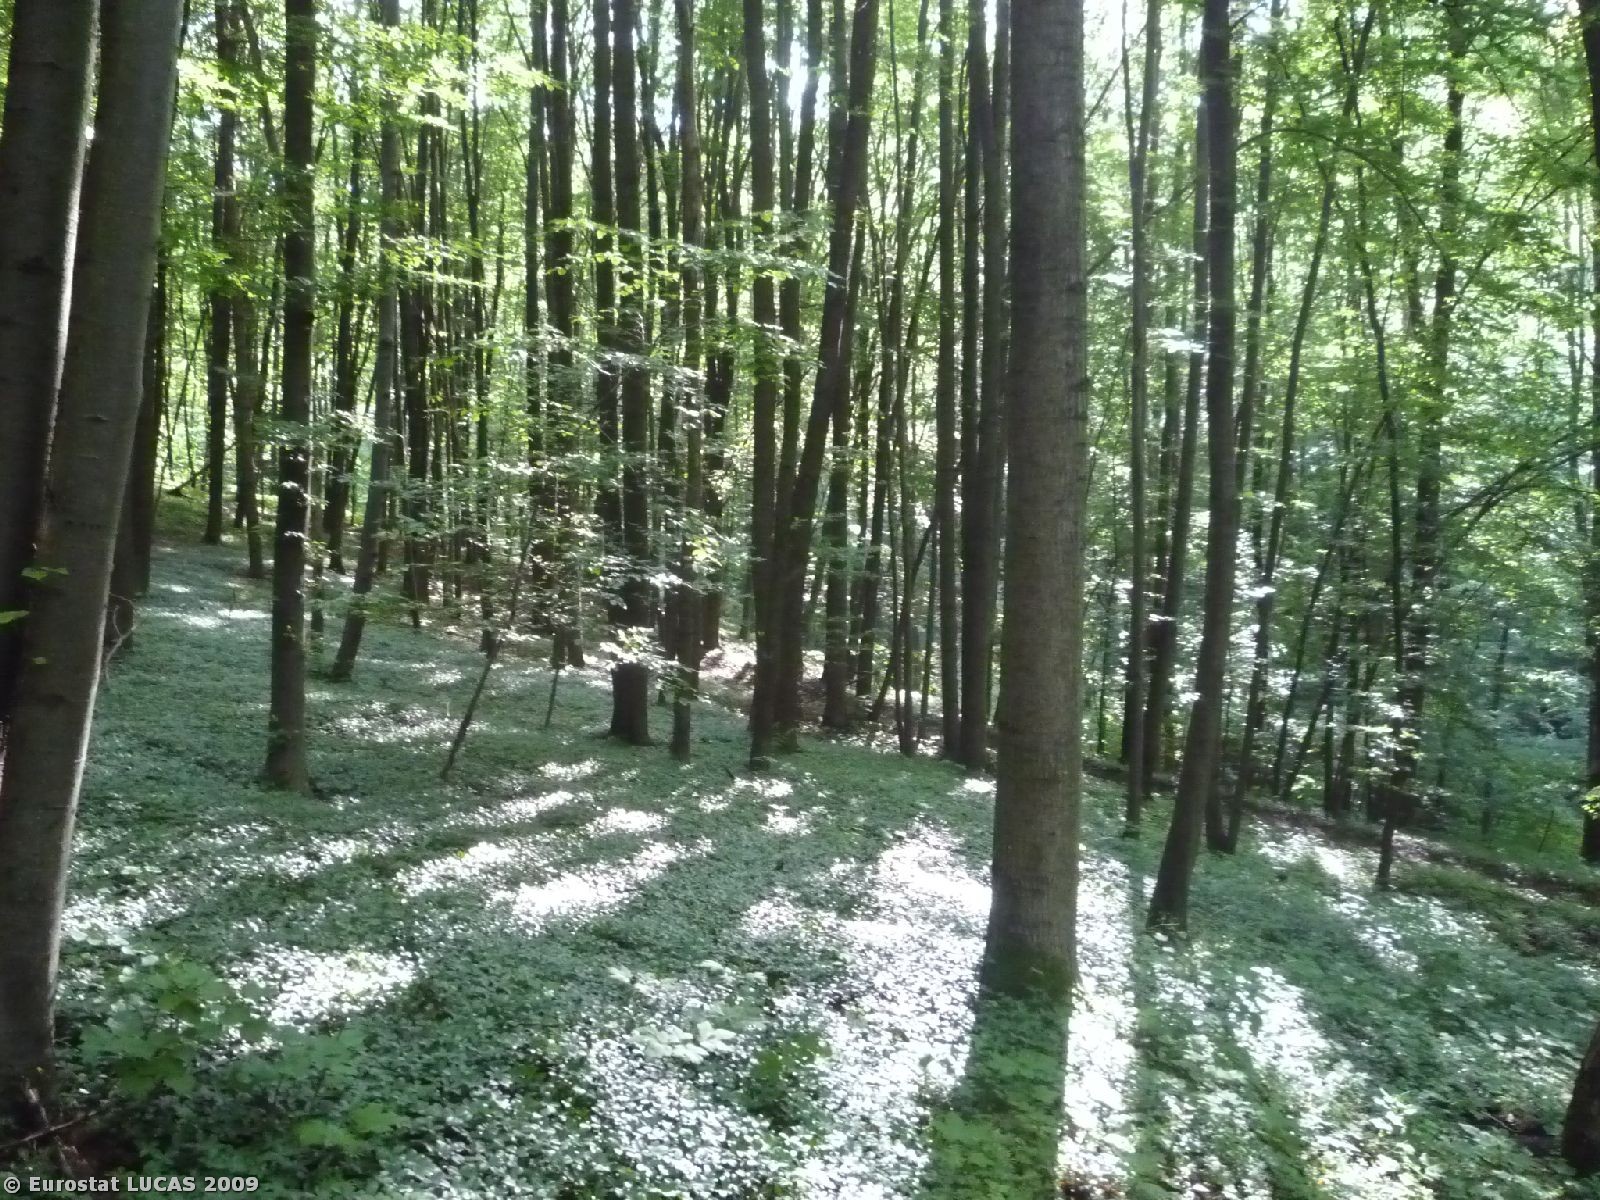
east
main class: Woodland
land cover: Broadleaved woodland
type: beech forest
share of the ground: > 75 %
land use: Forestry
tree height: > 5 m
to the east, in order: Broadleaved woodland; Tracks; Broadleaved woodland; Rivers and streams; Coniferous woodland; Mixed woodland
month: June
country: CZ
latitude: 50.4489
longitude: 15.4824
